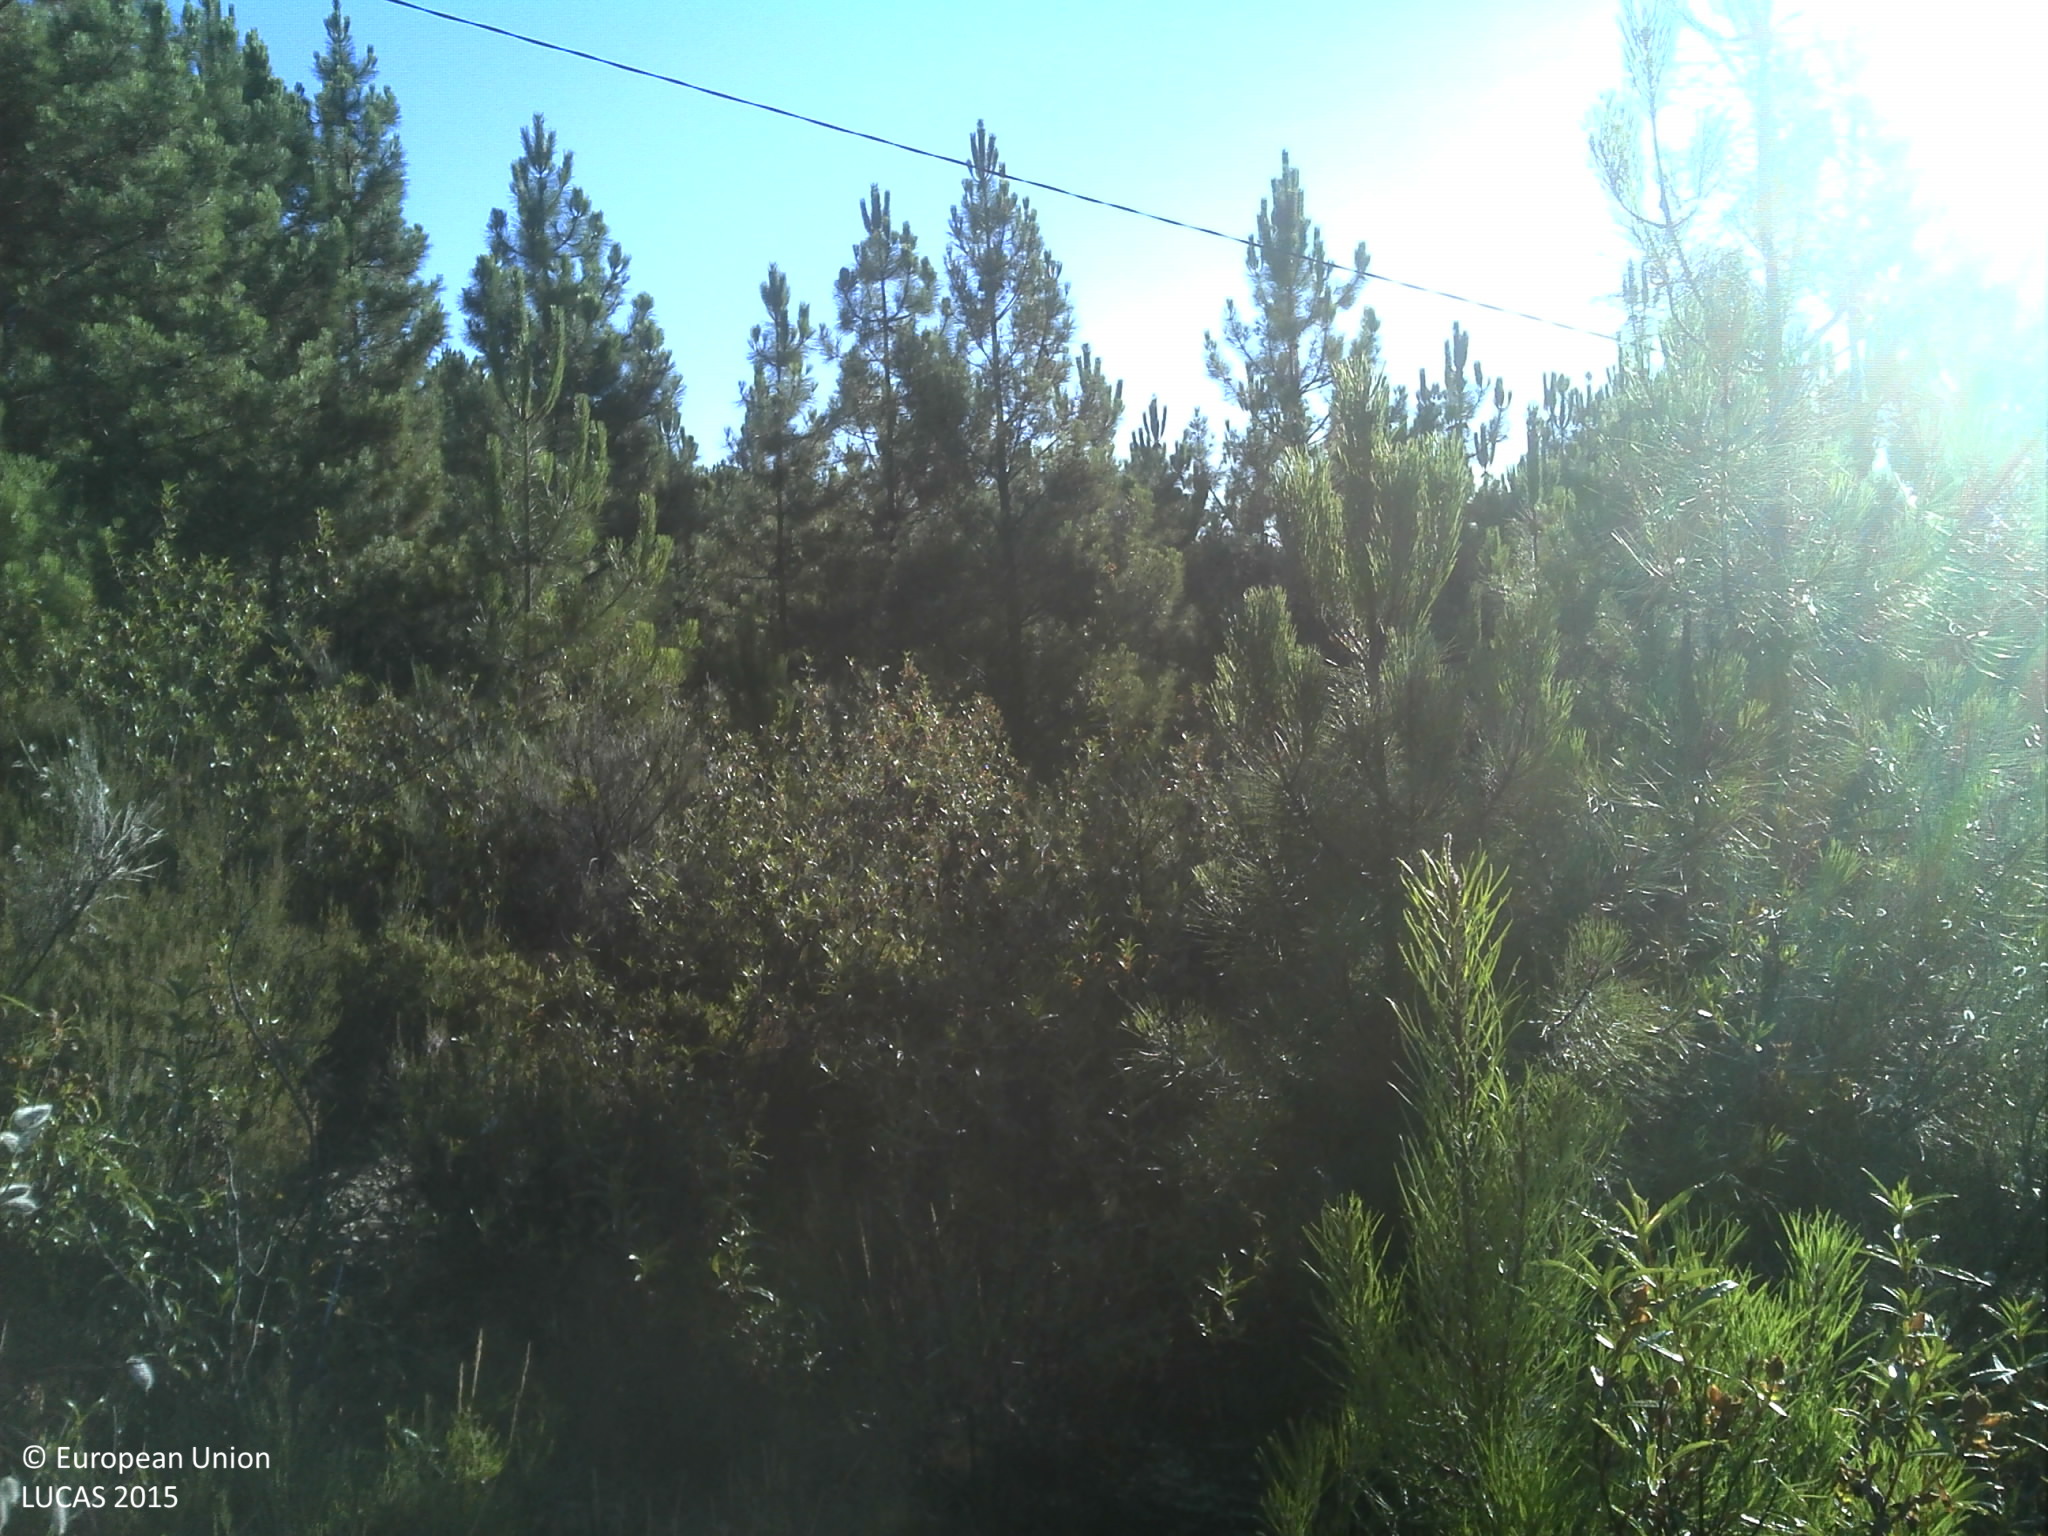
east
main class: Shrubland
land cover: Shrubland without tree cover
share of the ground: 50 - 75 %
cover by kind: shrubs 65 %, unconsolidated bare surface 35 %
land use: Forestry
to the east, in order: Shrubland without tree cover; Tracks; Pine dominated coniferous woodland; Shrubland without tree cover; Electric lines; Olive groves; Artificial constructions in urban areas; Olive groves; Dry stone walls; Olive groves; Dry stone walls; Olive groves; Dry stone walls; Olive groves; Dry stone walls; Olive groves; Dry stone walls; Olive groves; Dry stone walls; Olive groves; Dry stone walls; Rivers and streams
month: July
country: PT
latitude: 40.0943
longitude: -7.6430
